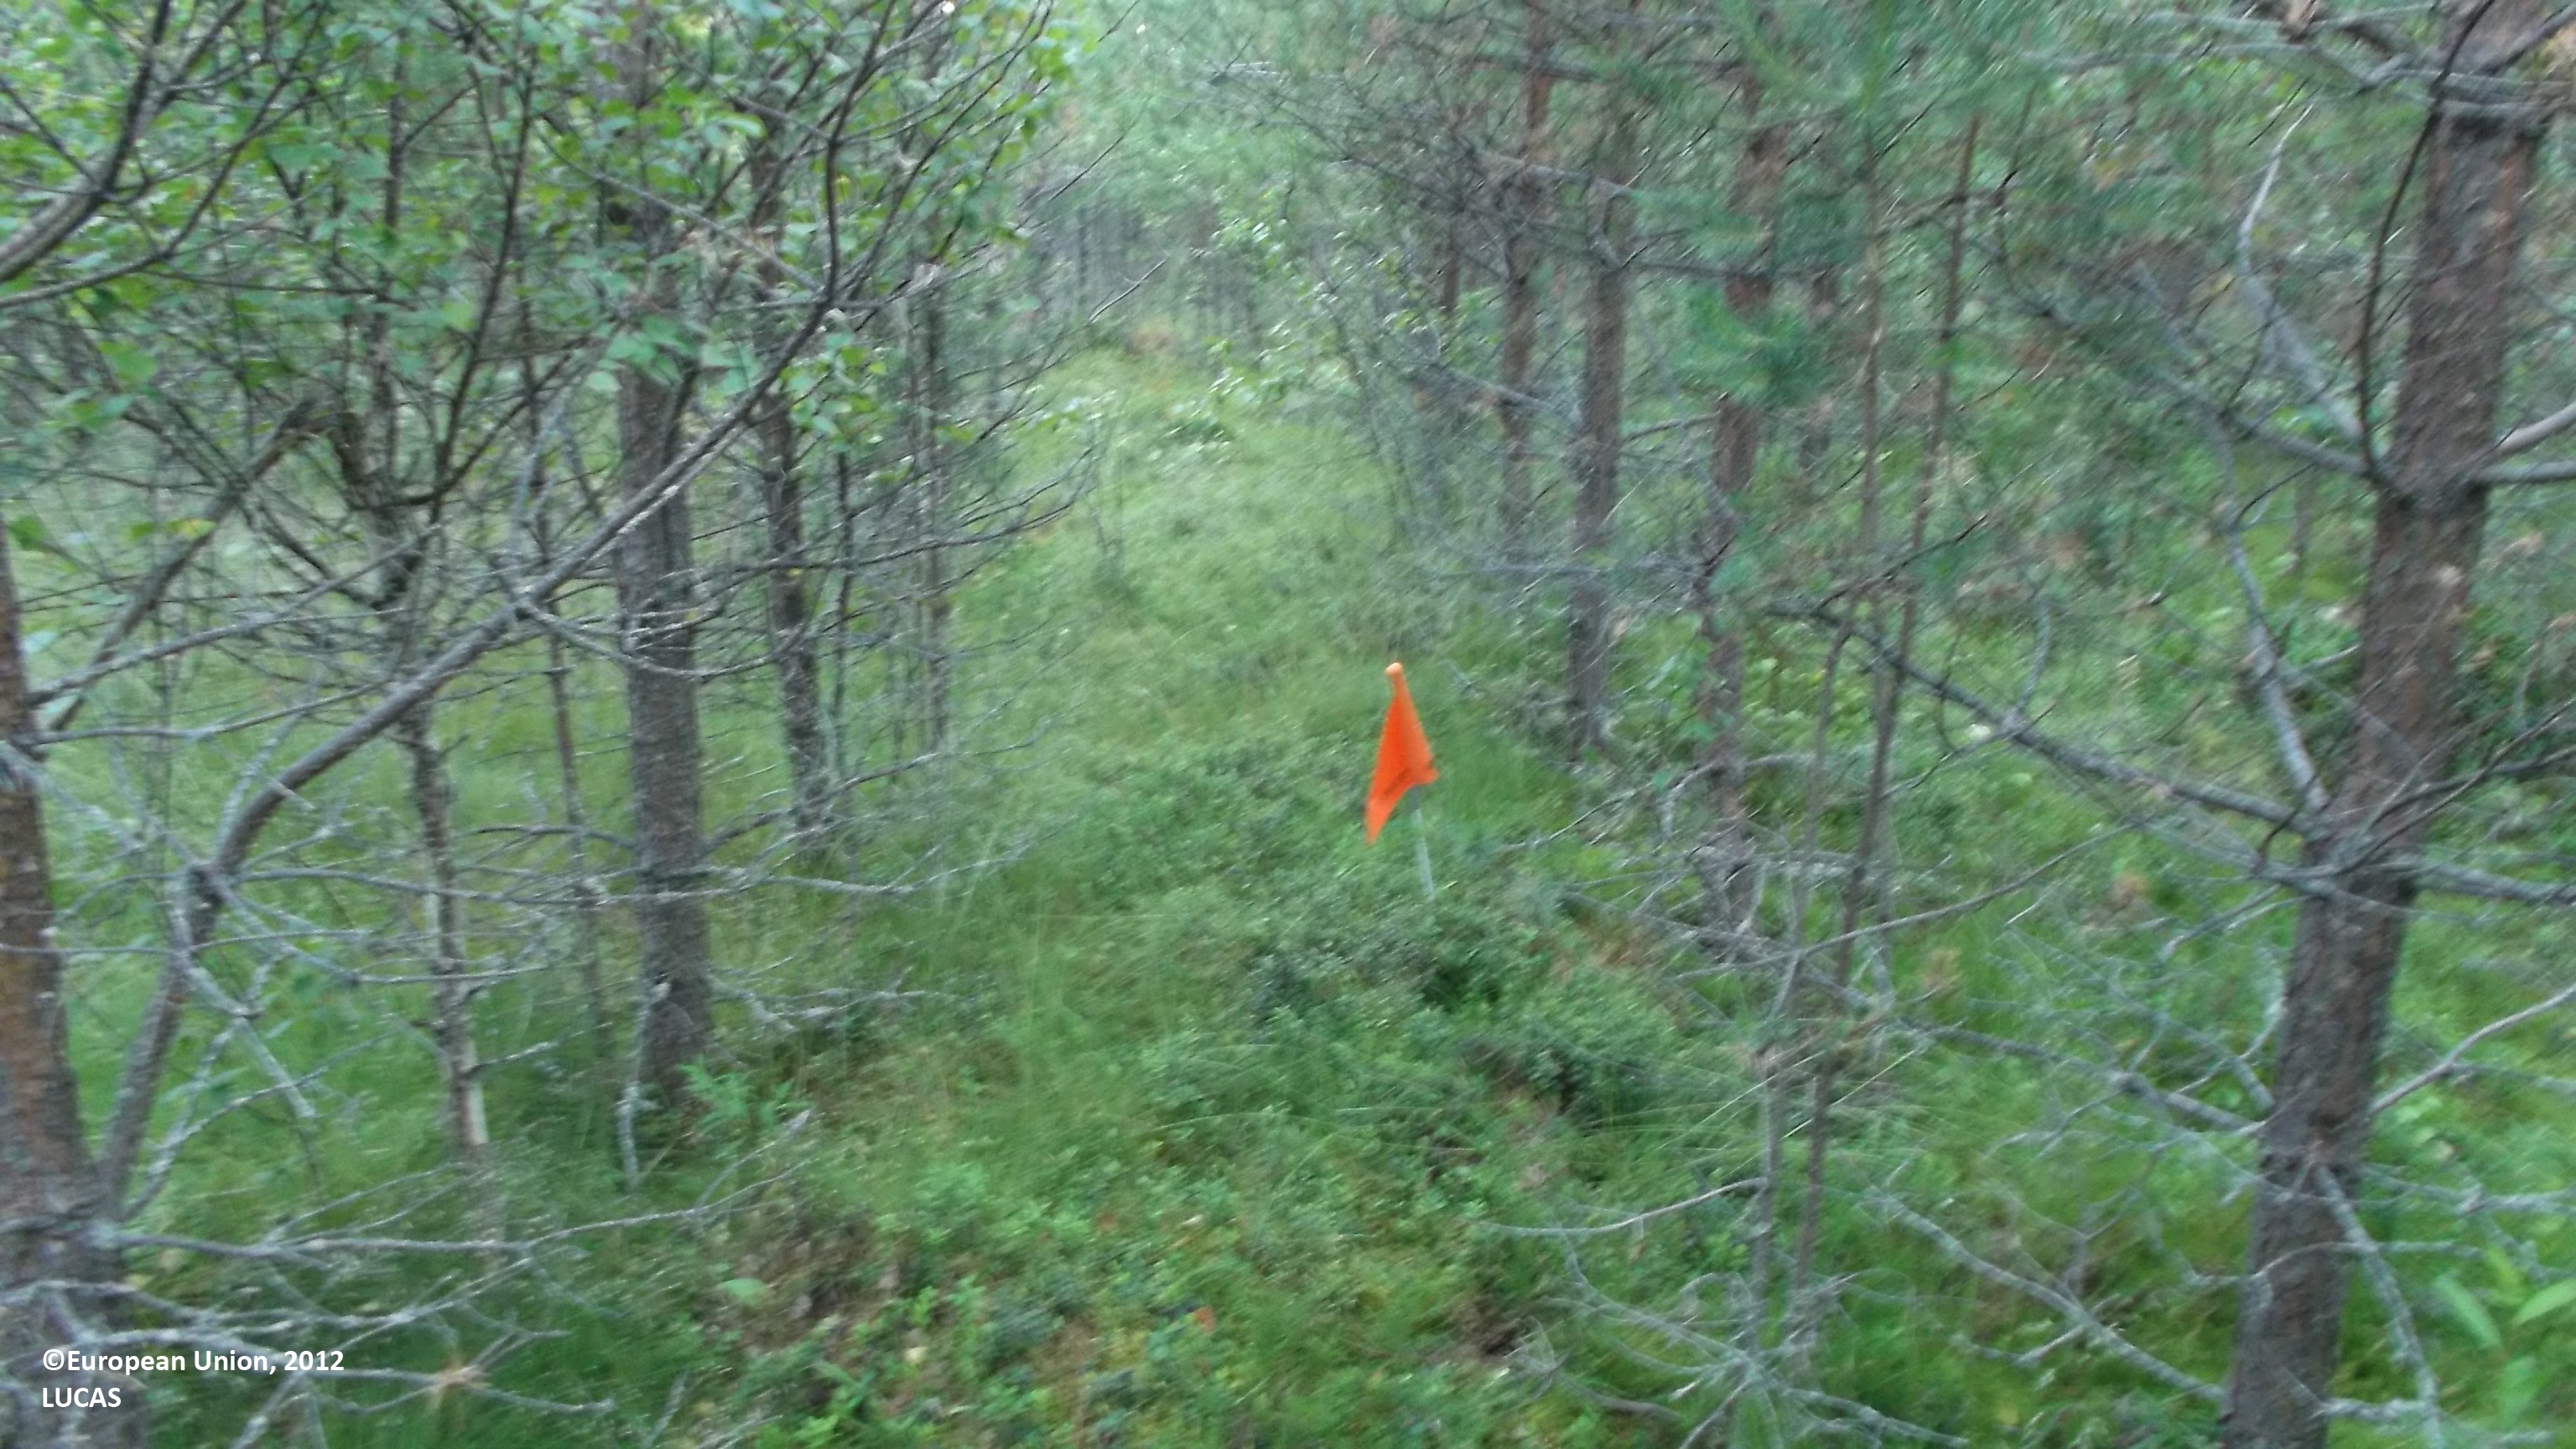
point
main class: Woodland
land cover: Pine dominated mixed woodland
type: boreal forest
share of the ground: > 75 %
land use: Forestry
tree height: > 5 m
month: July
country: FI
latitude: 63.6068
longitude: 23.1821
